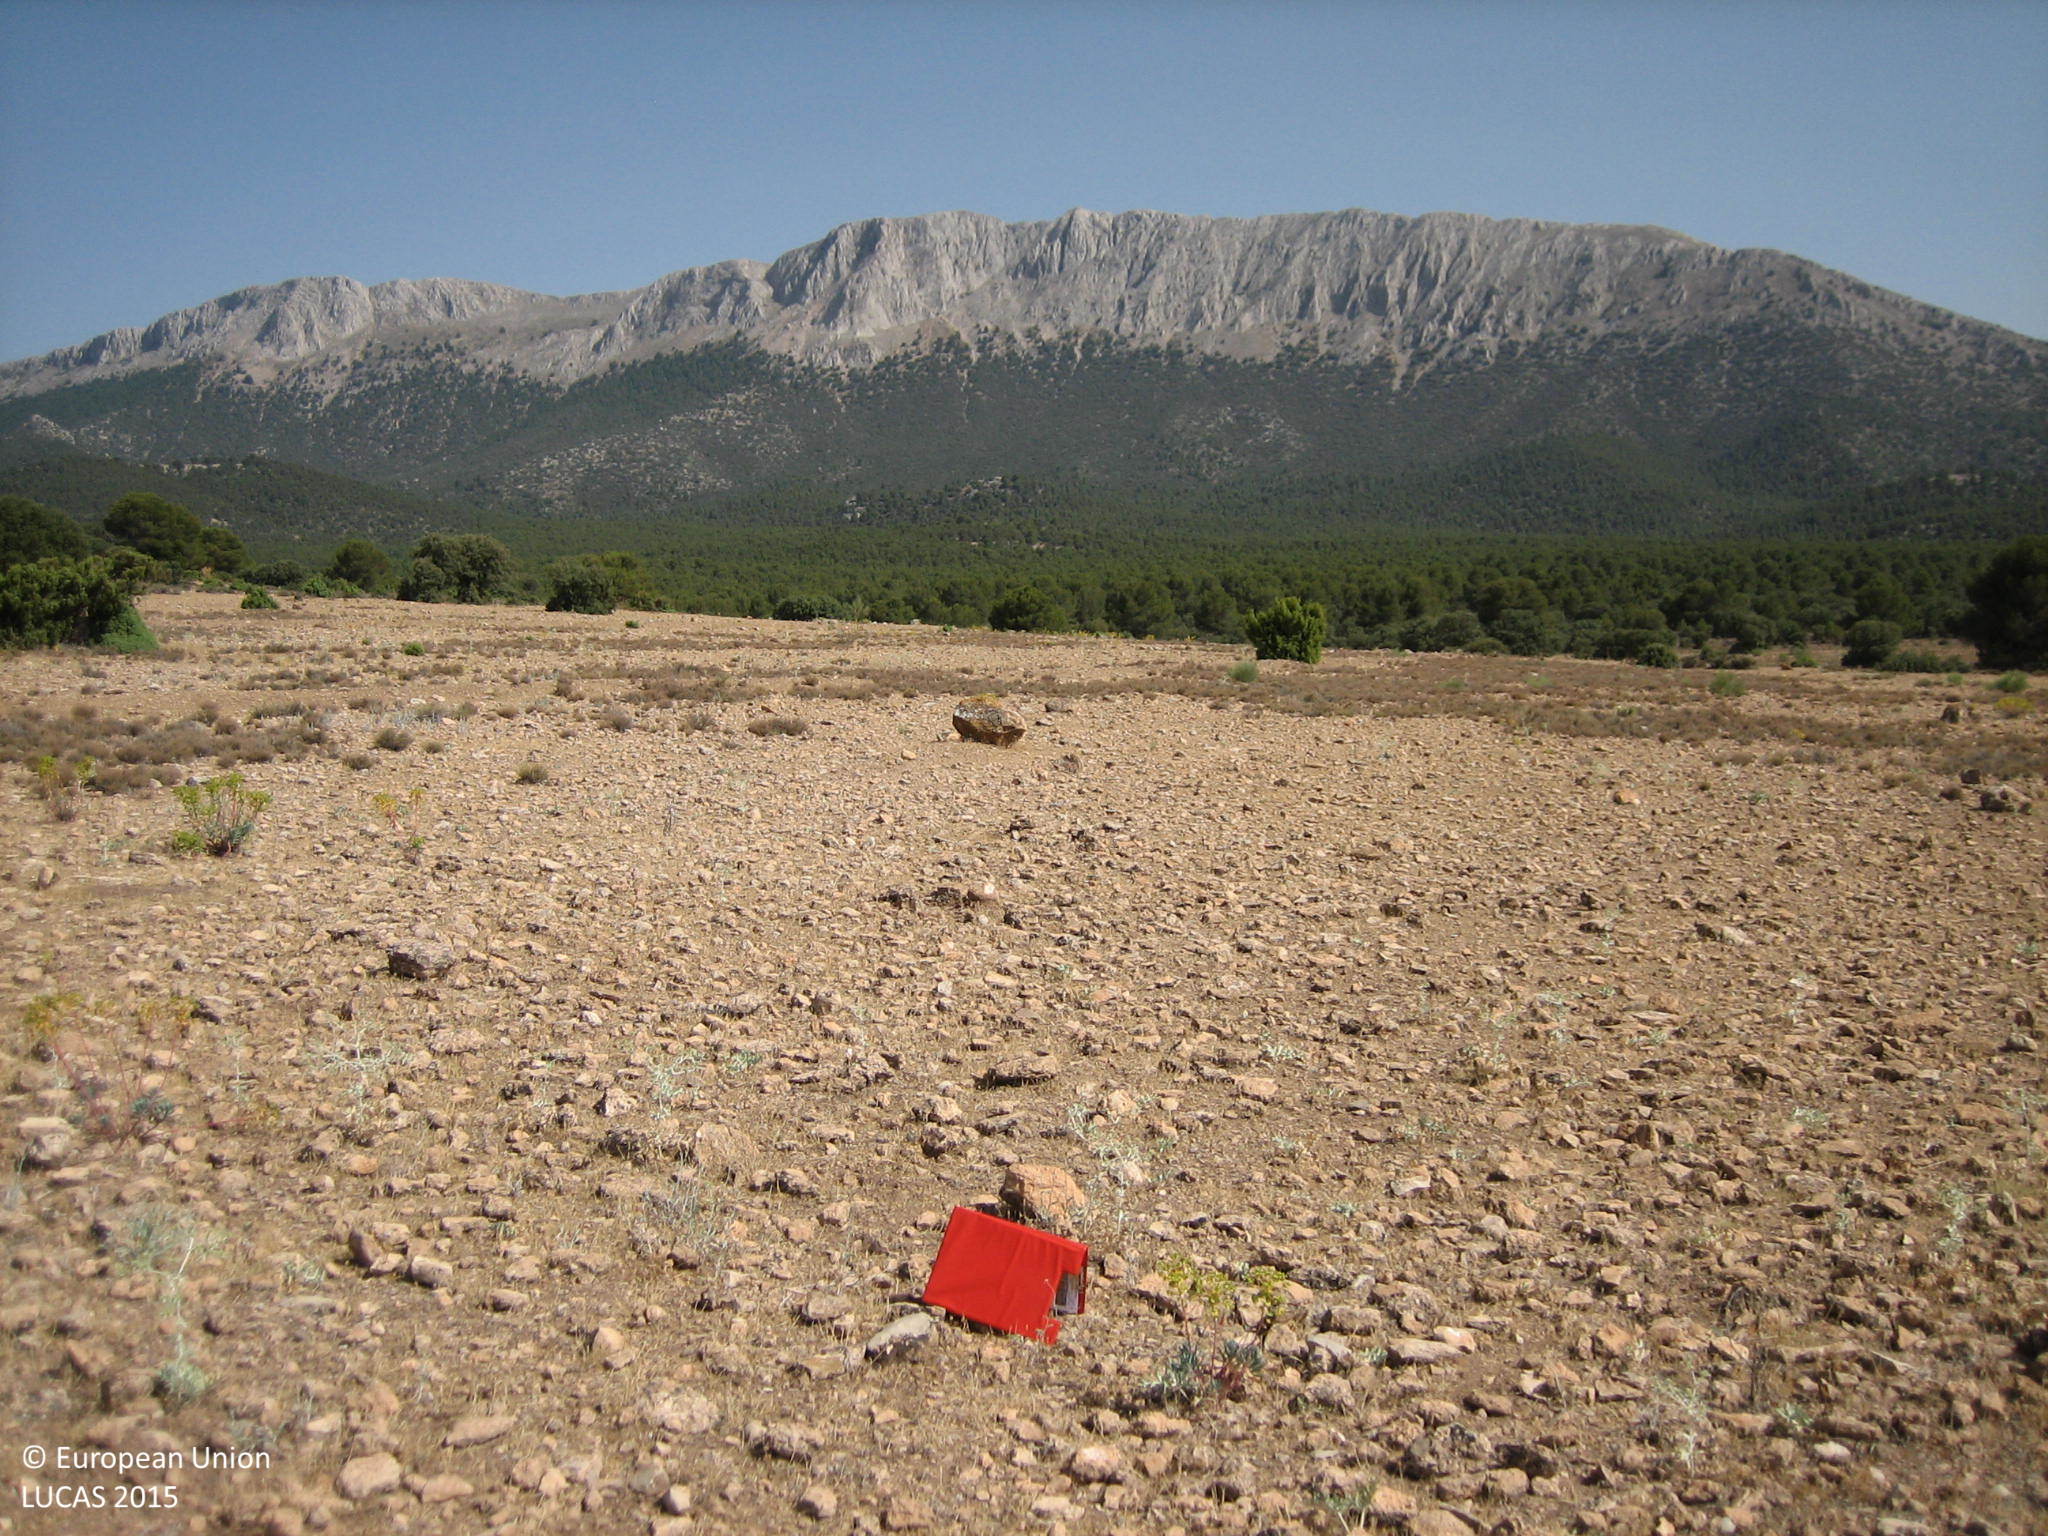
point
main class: Grassland
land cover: Grassland without tree/shrub cover
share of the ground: 10 - 25 %
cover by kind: unconsolidated bare surface 70 %, consolidated bare surface 15 %, herbaceous plants 10 %, shrubs 5 %
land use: Agriculture (excluding fallow land and kitchen gardens)
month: July
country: ES
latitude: 37.7009
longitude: -2.2698
